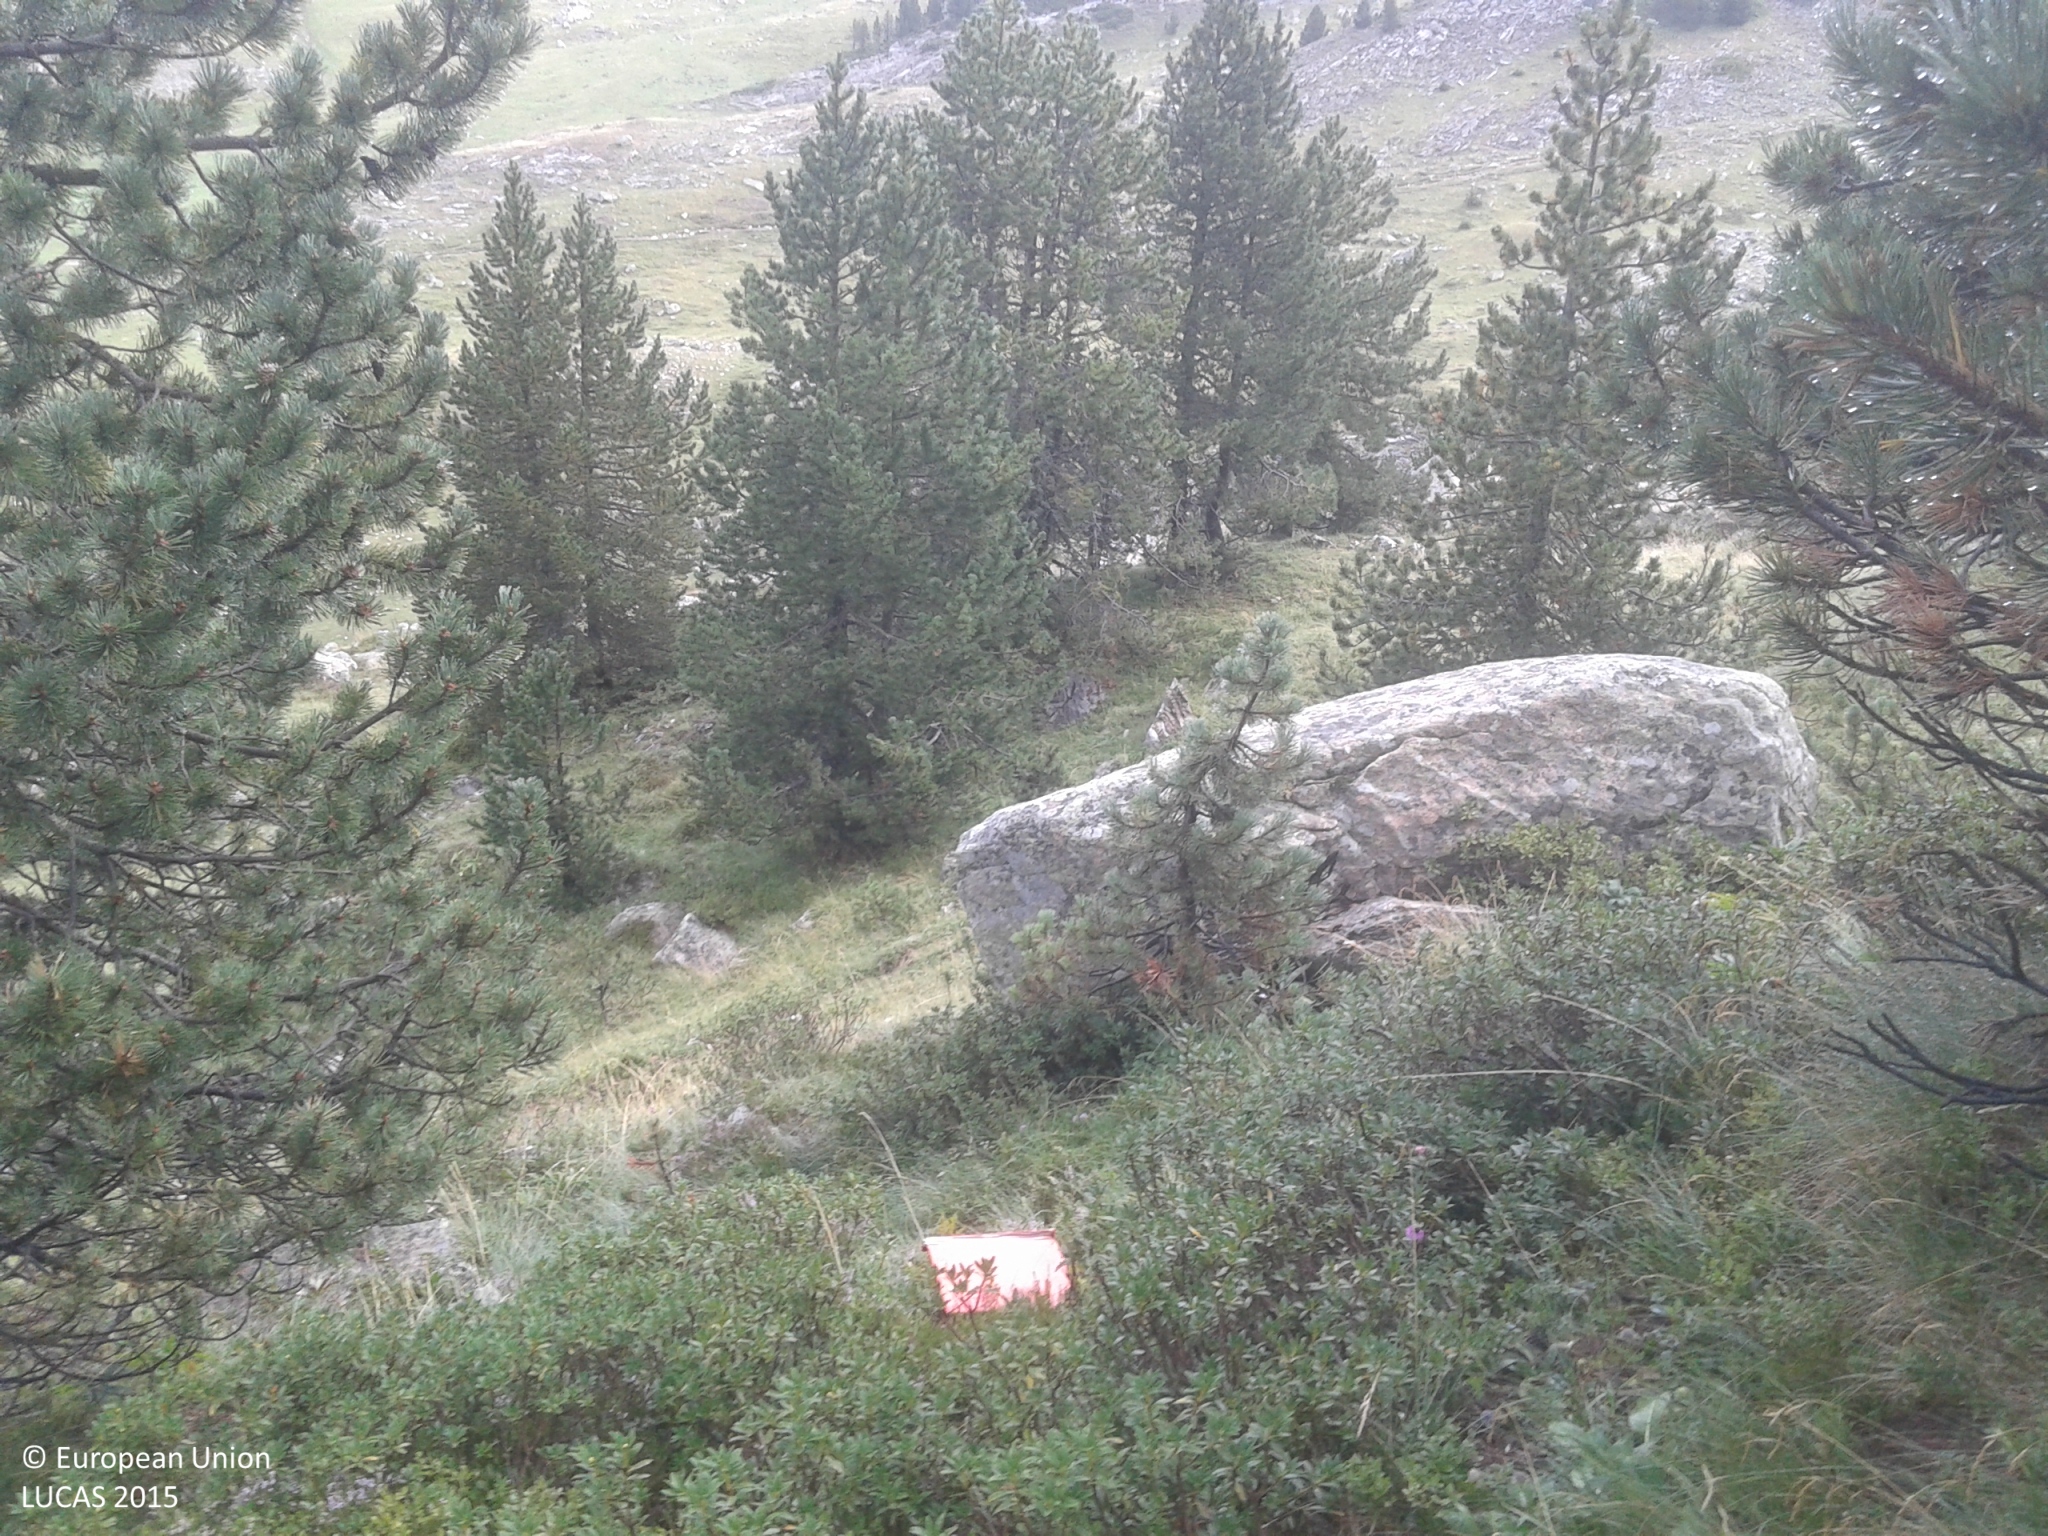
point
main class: Woodland
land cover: Pine dominated coniferous woodland
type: alpine coniferous forest
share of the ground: 10 - 25 %
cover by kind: shrubs 60 %, herbaceous plants 20 %, coniferous forest trees 15 %, lichens and mosses 5 %
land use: Agriculture (excluding fallow land and kitchen gardens)
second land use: Sport
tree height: > 5 m
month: August
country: ES
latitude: 42.7030
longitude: 0.9595
